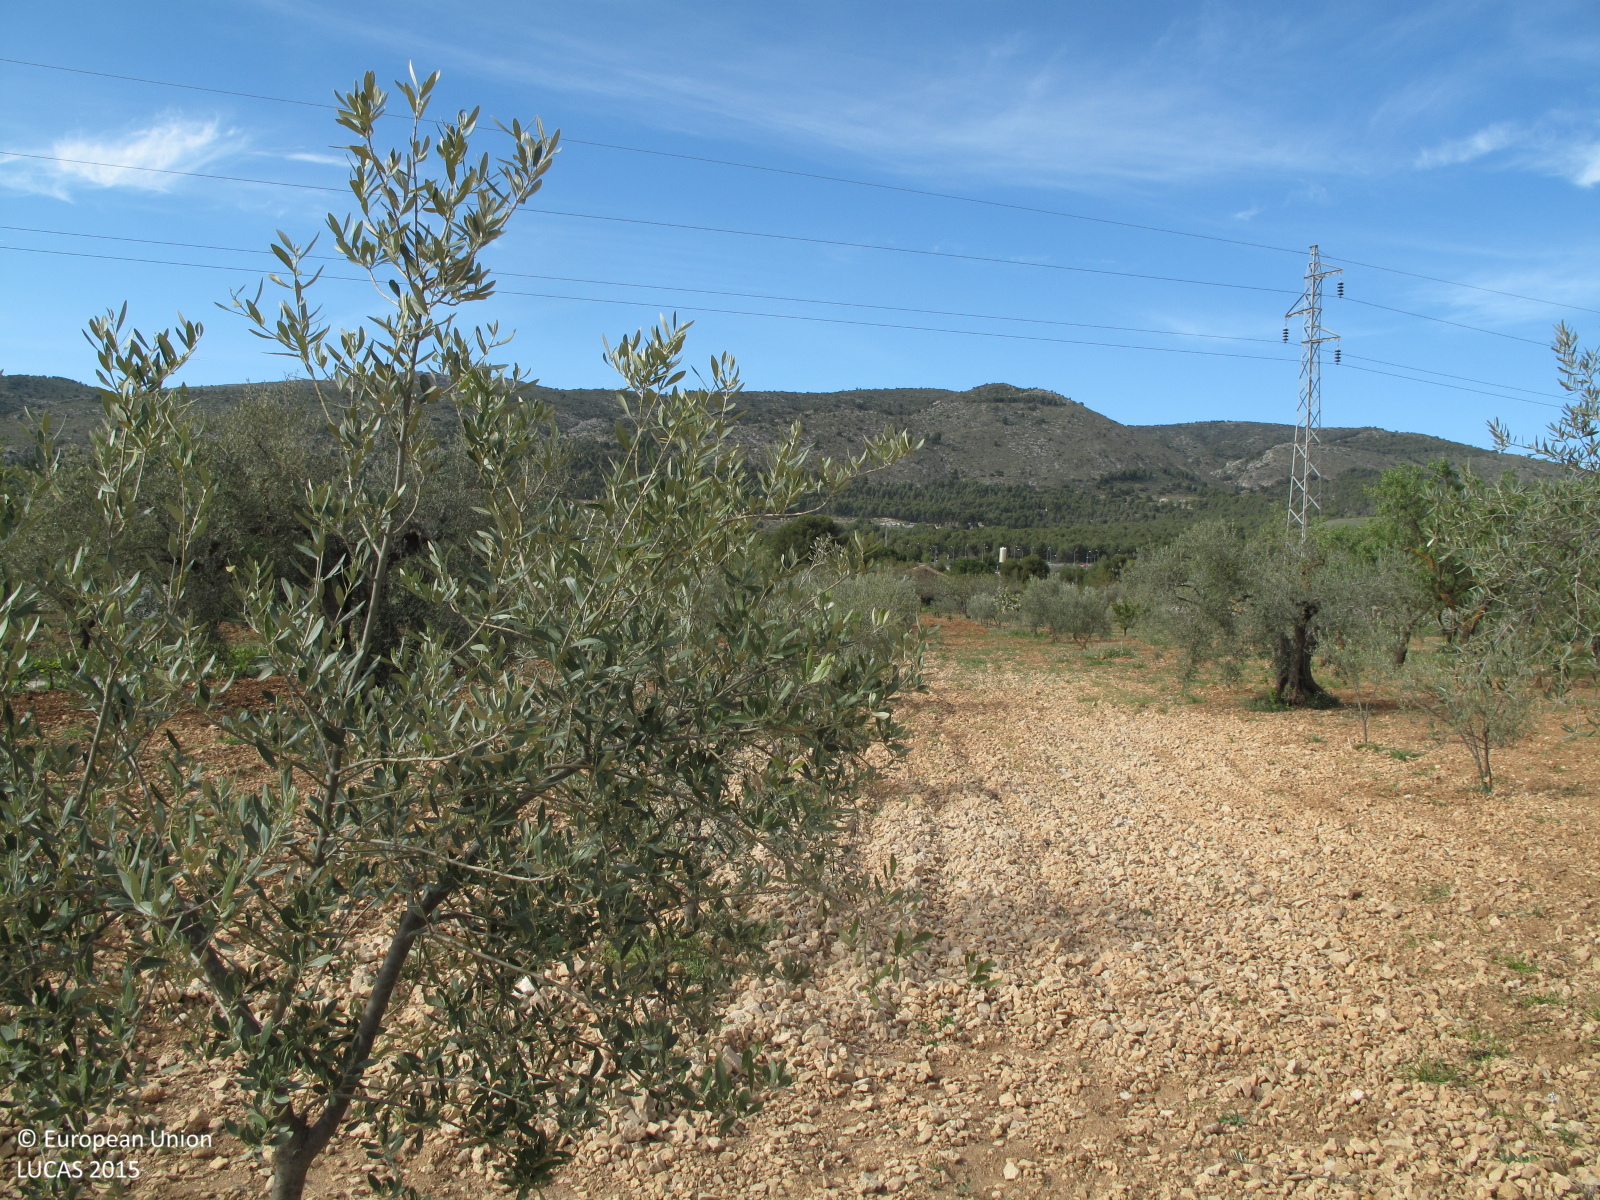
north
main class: Cropland
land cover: Olive groves
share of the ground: 10 - 25 %
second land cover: Other bare soil
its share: > 75 %
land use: Agriculture (excluding fallow land and kitchen gardens)
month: April
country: ES
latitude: 38.6211
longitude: -0.5441
